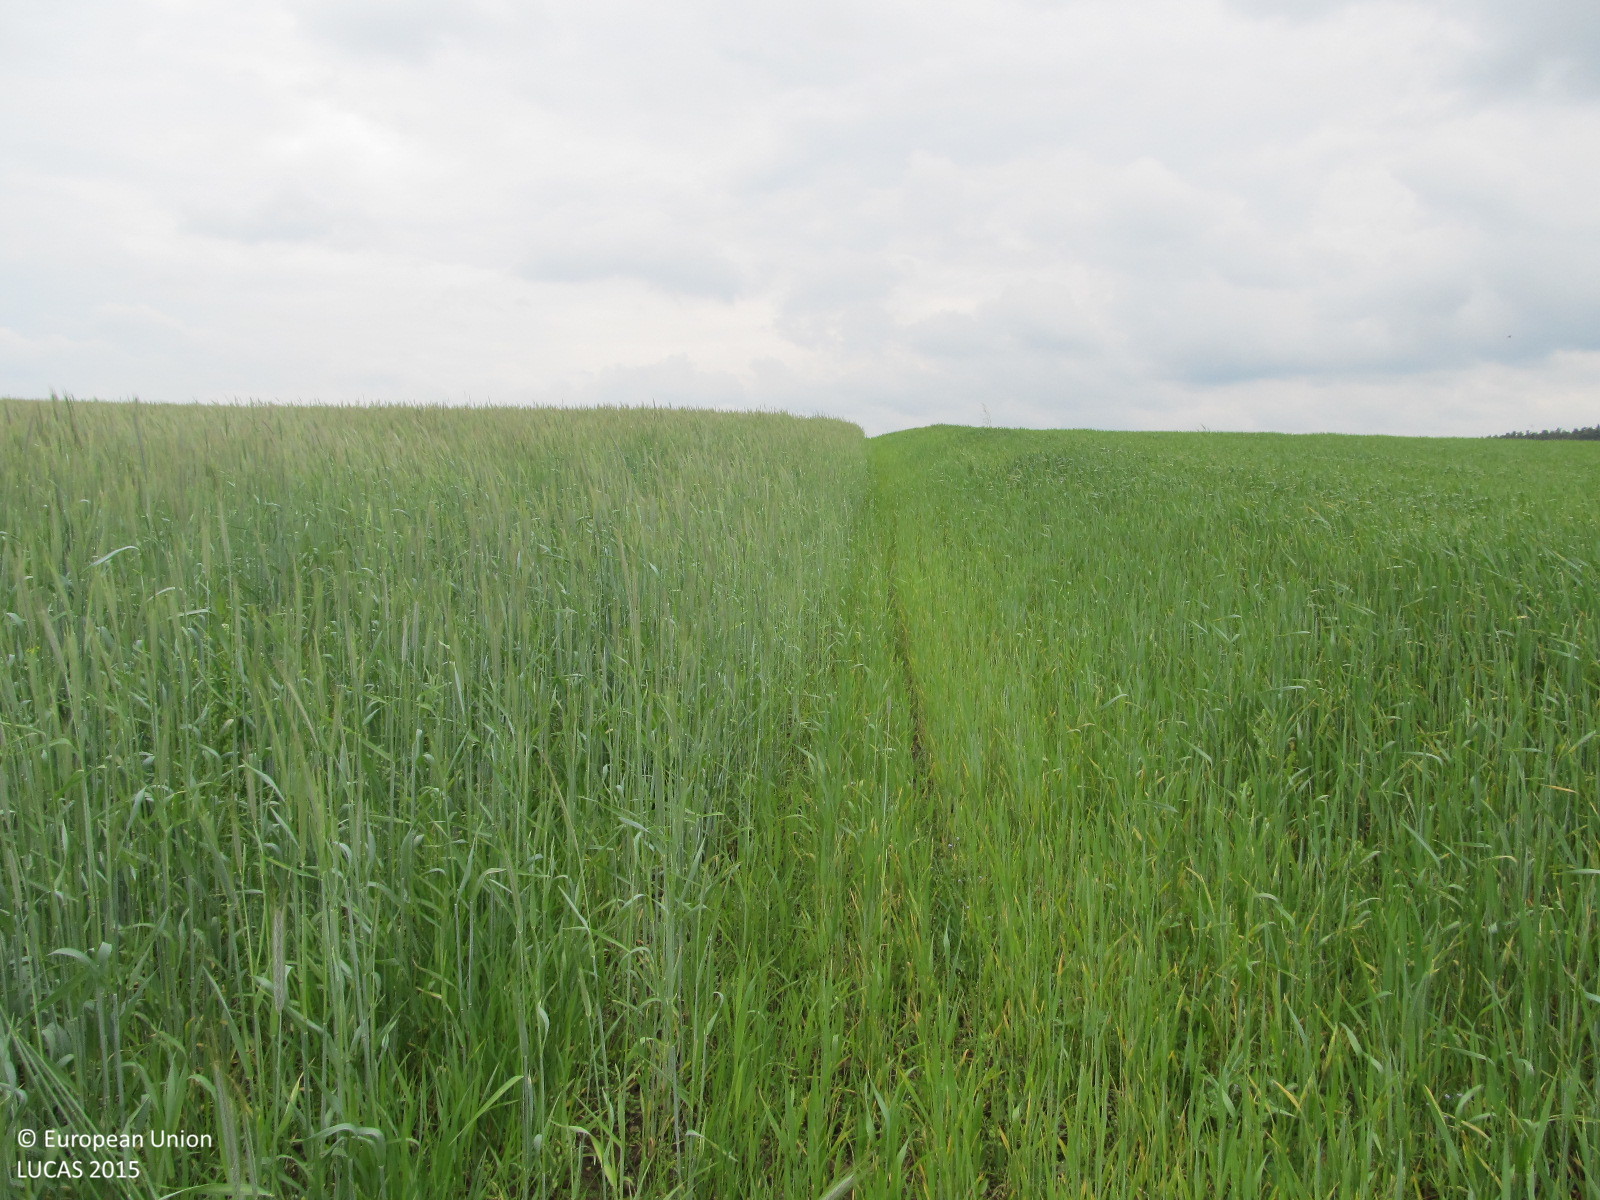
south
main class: Cropland
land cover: Common wheat
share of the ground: > 75 %
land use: Agriculture (excluding fallow land and kitchen gardens)
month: May
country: AT
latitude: 48.6646
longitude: 15.4748
